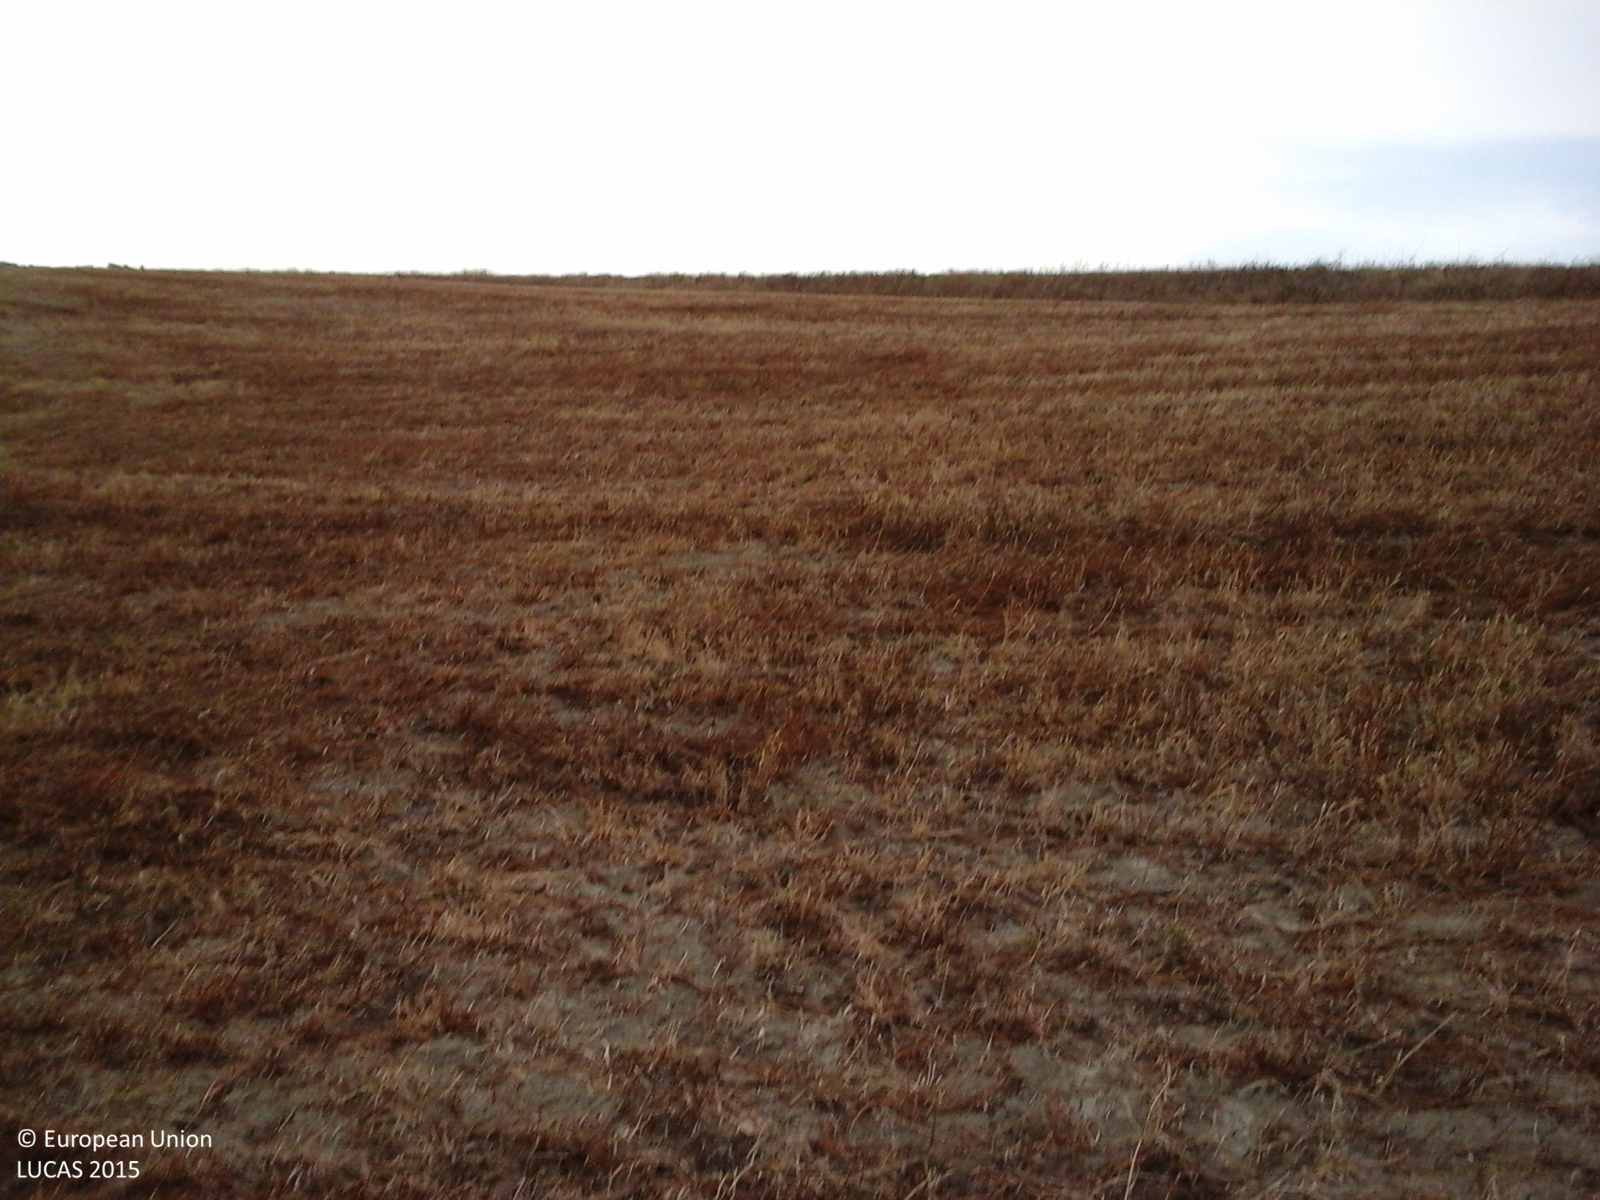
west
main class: Cropland
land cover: Temporary grasslands
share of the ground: > 75 %
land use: Agriculture (excluding fallow land and kitchen gardens)
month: July
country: IT
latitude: 43.0579
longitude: 11.5301
